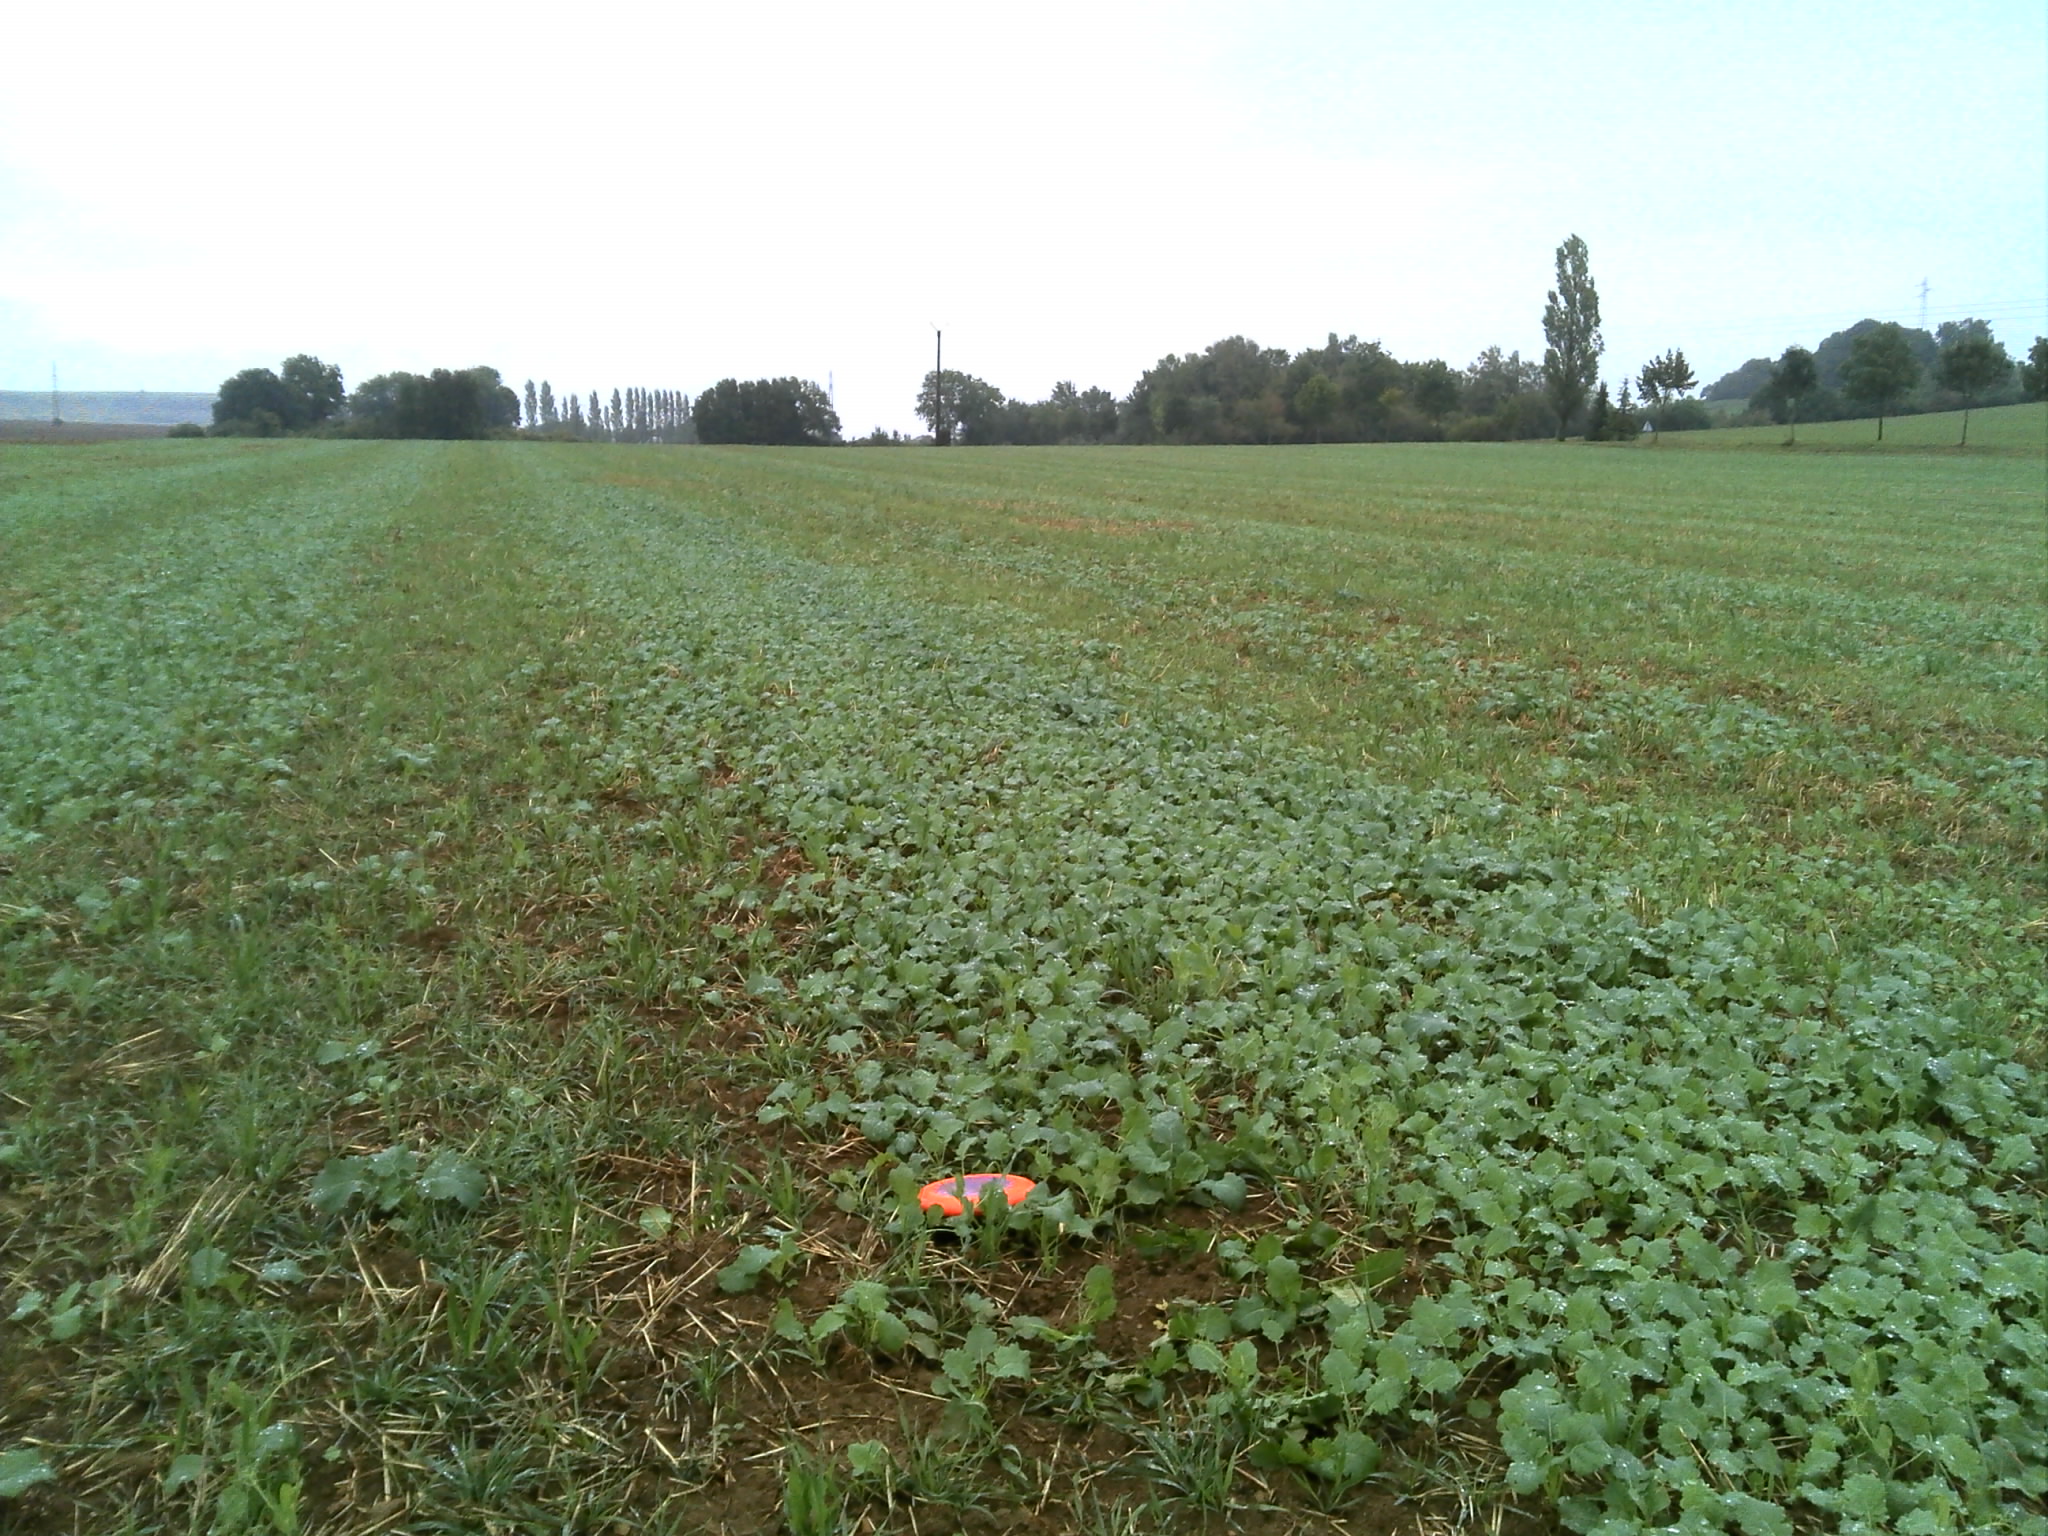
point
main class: Cropland
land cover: Rape and turnip rape
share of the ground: < 10 %
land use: Agriculture (excluding fallow land and kitchen gardens)
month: September
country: FR
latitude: 49.3367
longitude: 5.9119
